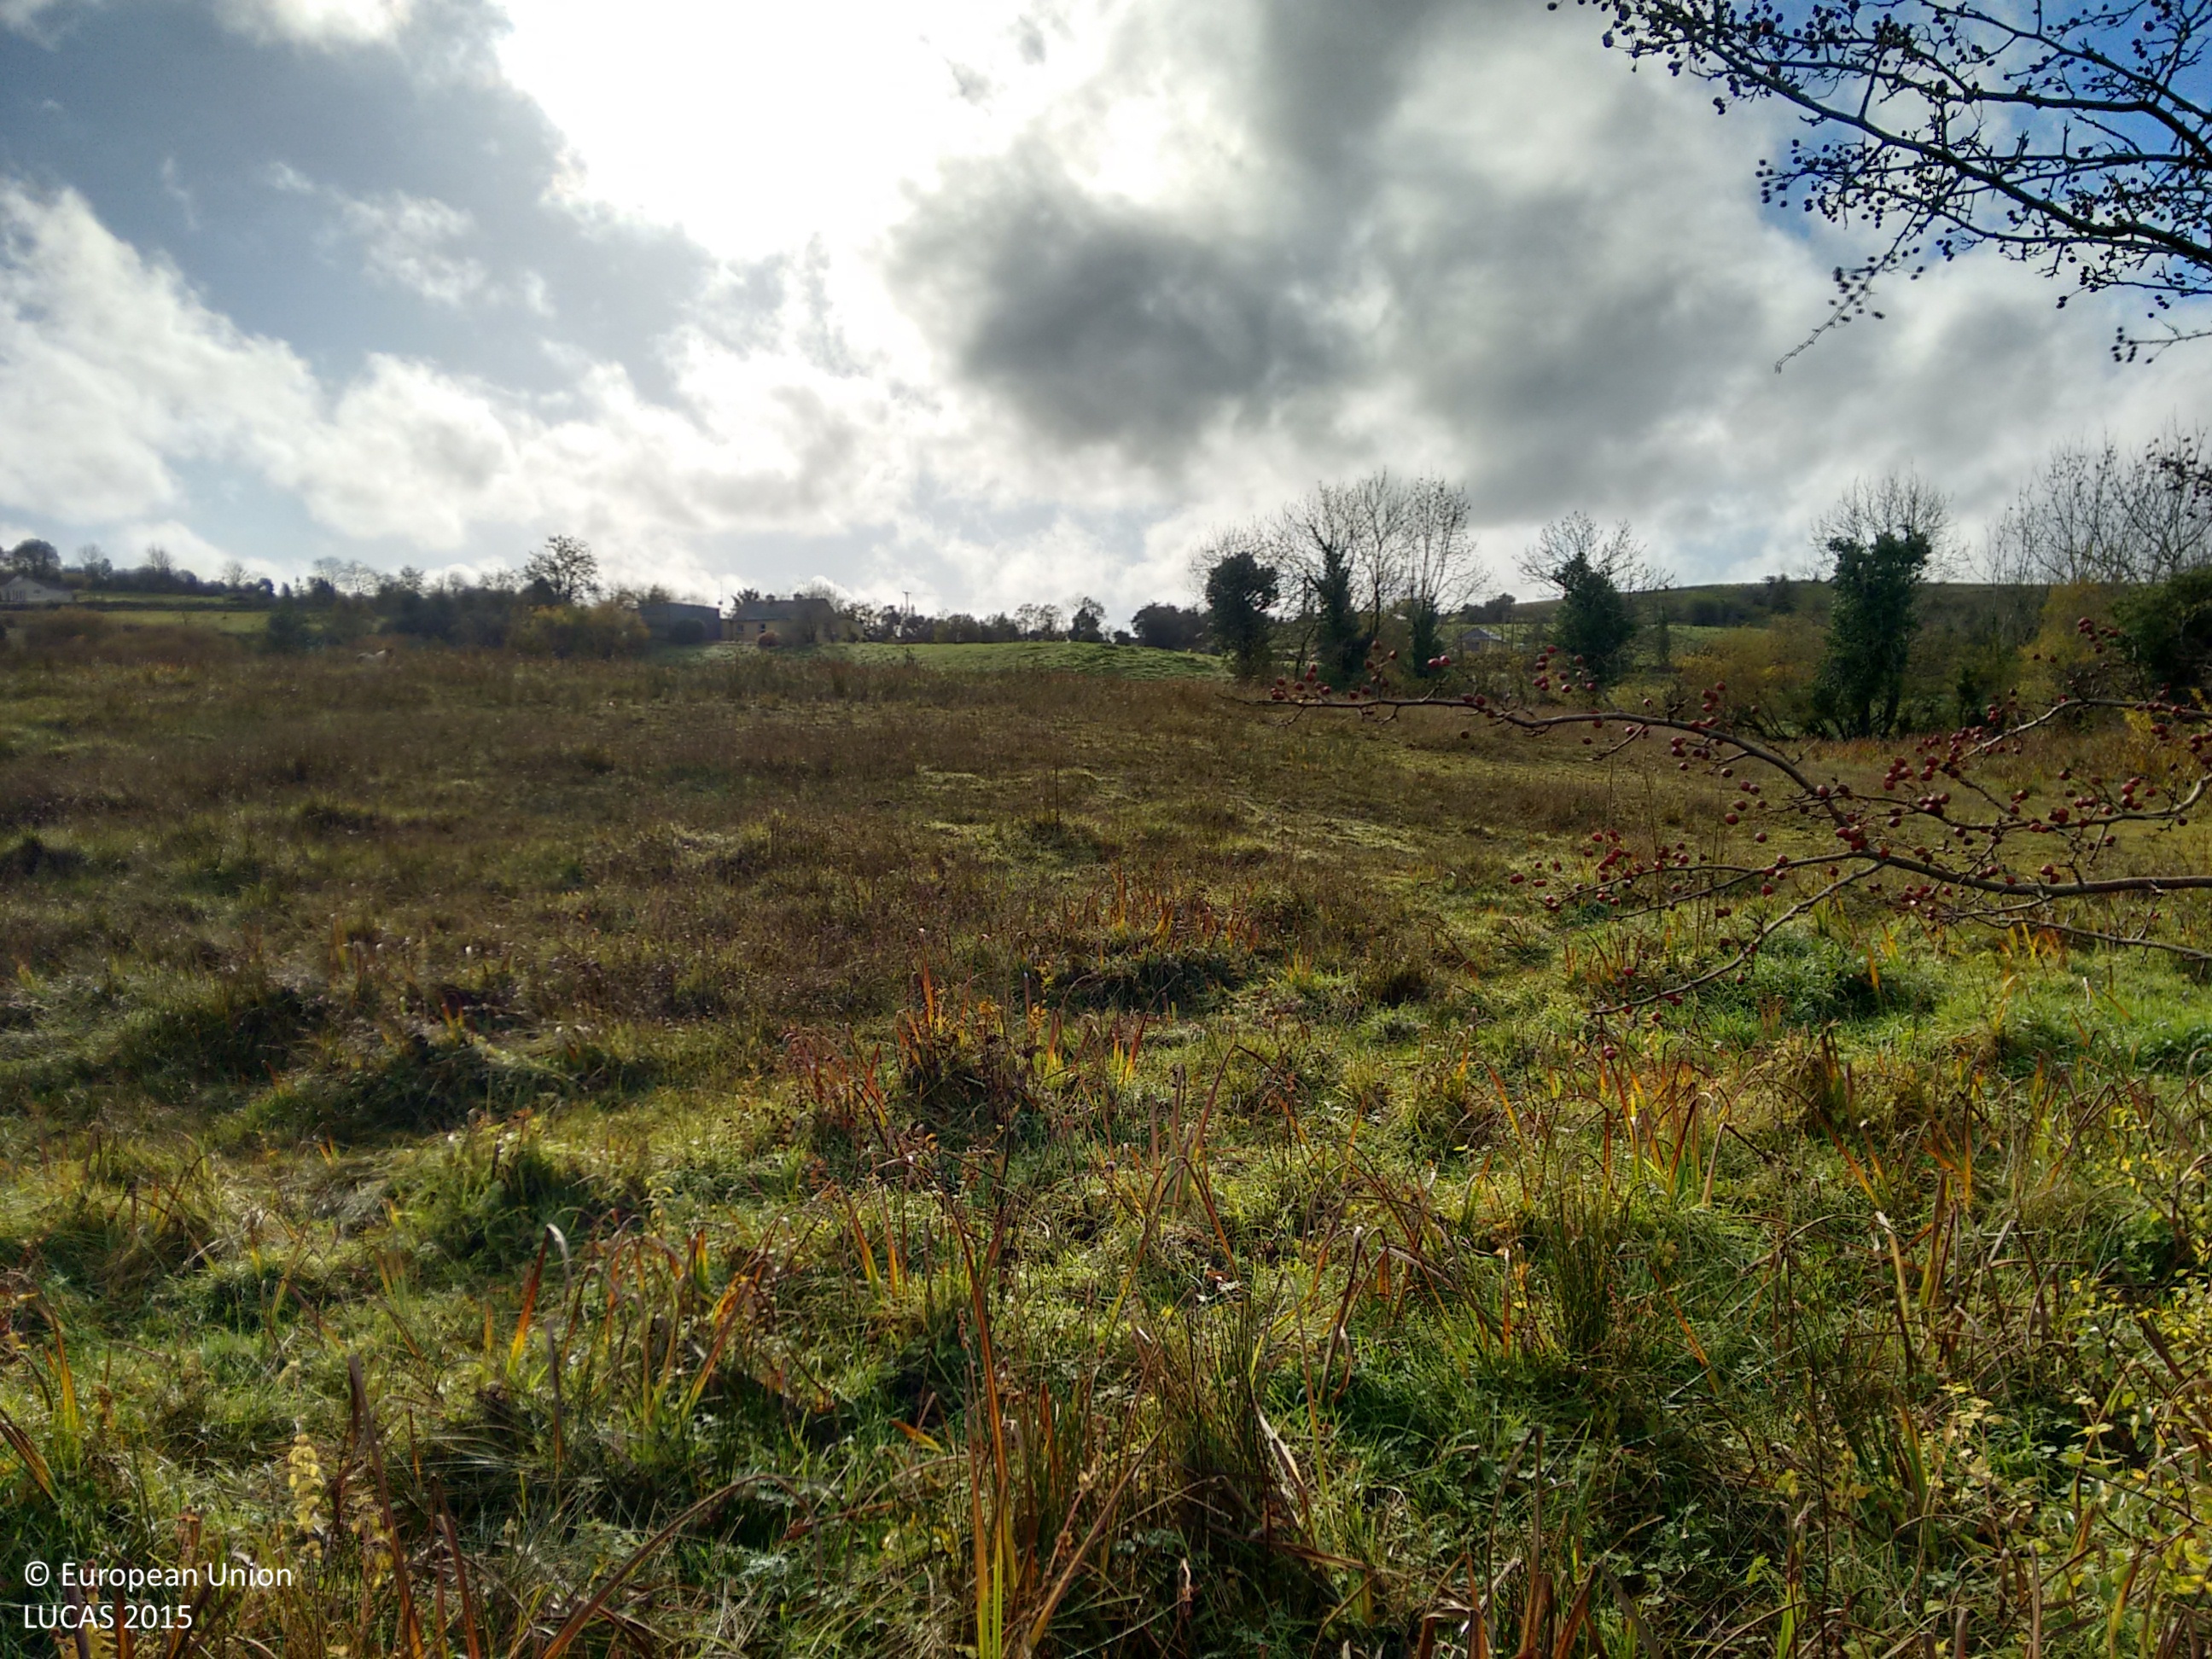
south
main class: Grassland
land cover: Grassland with sparse tree/shrub cover
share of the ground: > 75 %
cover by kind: herbaceous plants 95 %, broadleaved forest trees 5 %
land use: Agriculture (excluding fallow land and kitchen gardens)
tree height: > 5 m
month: October
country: IE
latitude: 54.0520
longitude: -8.2214
